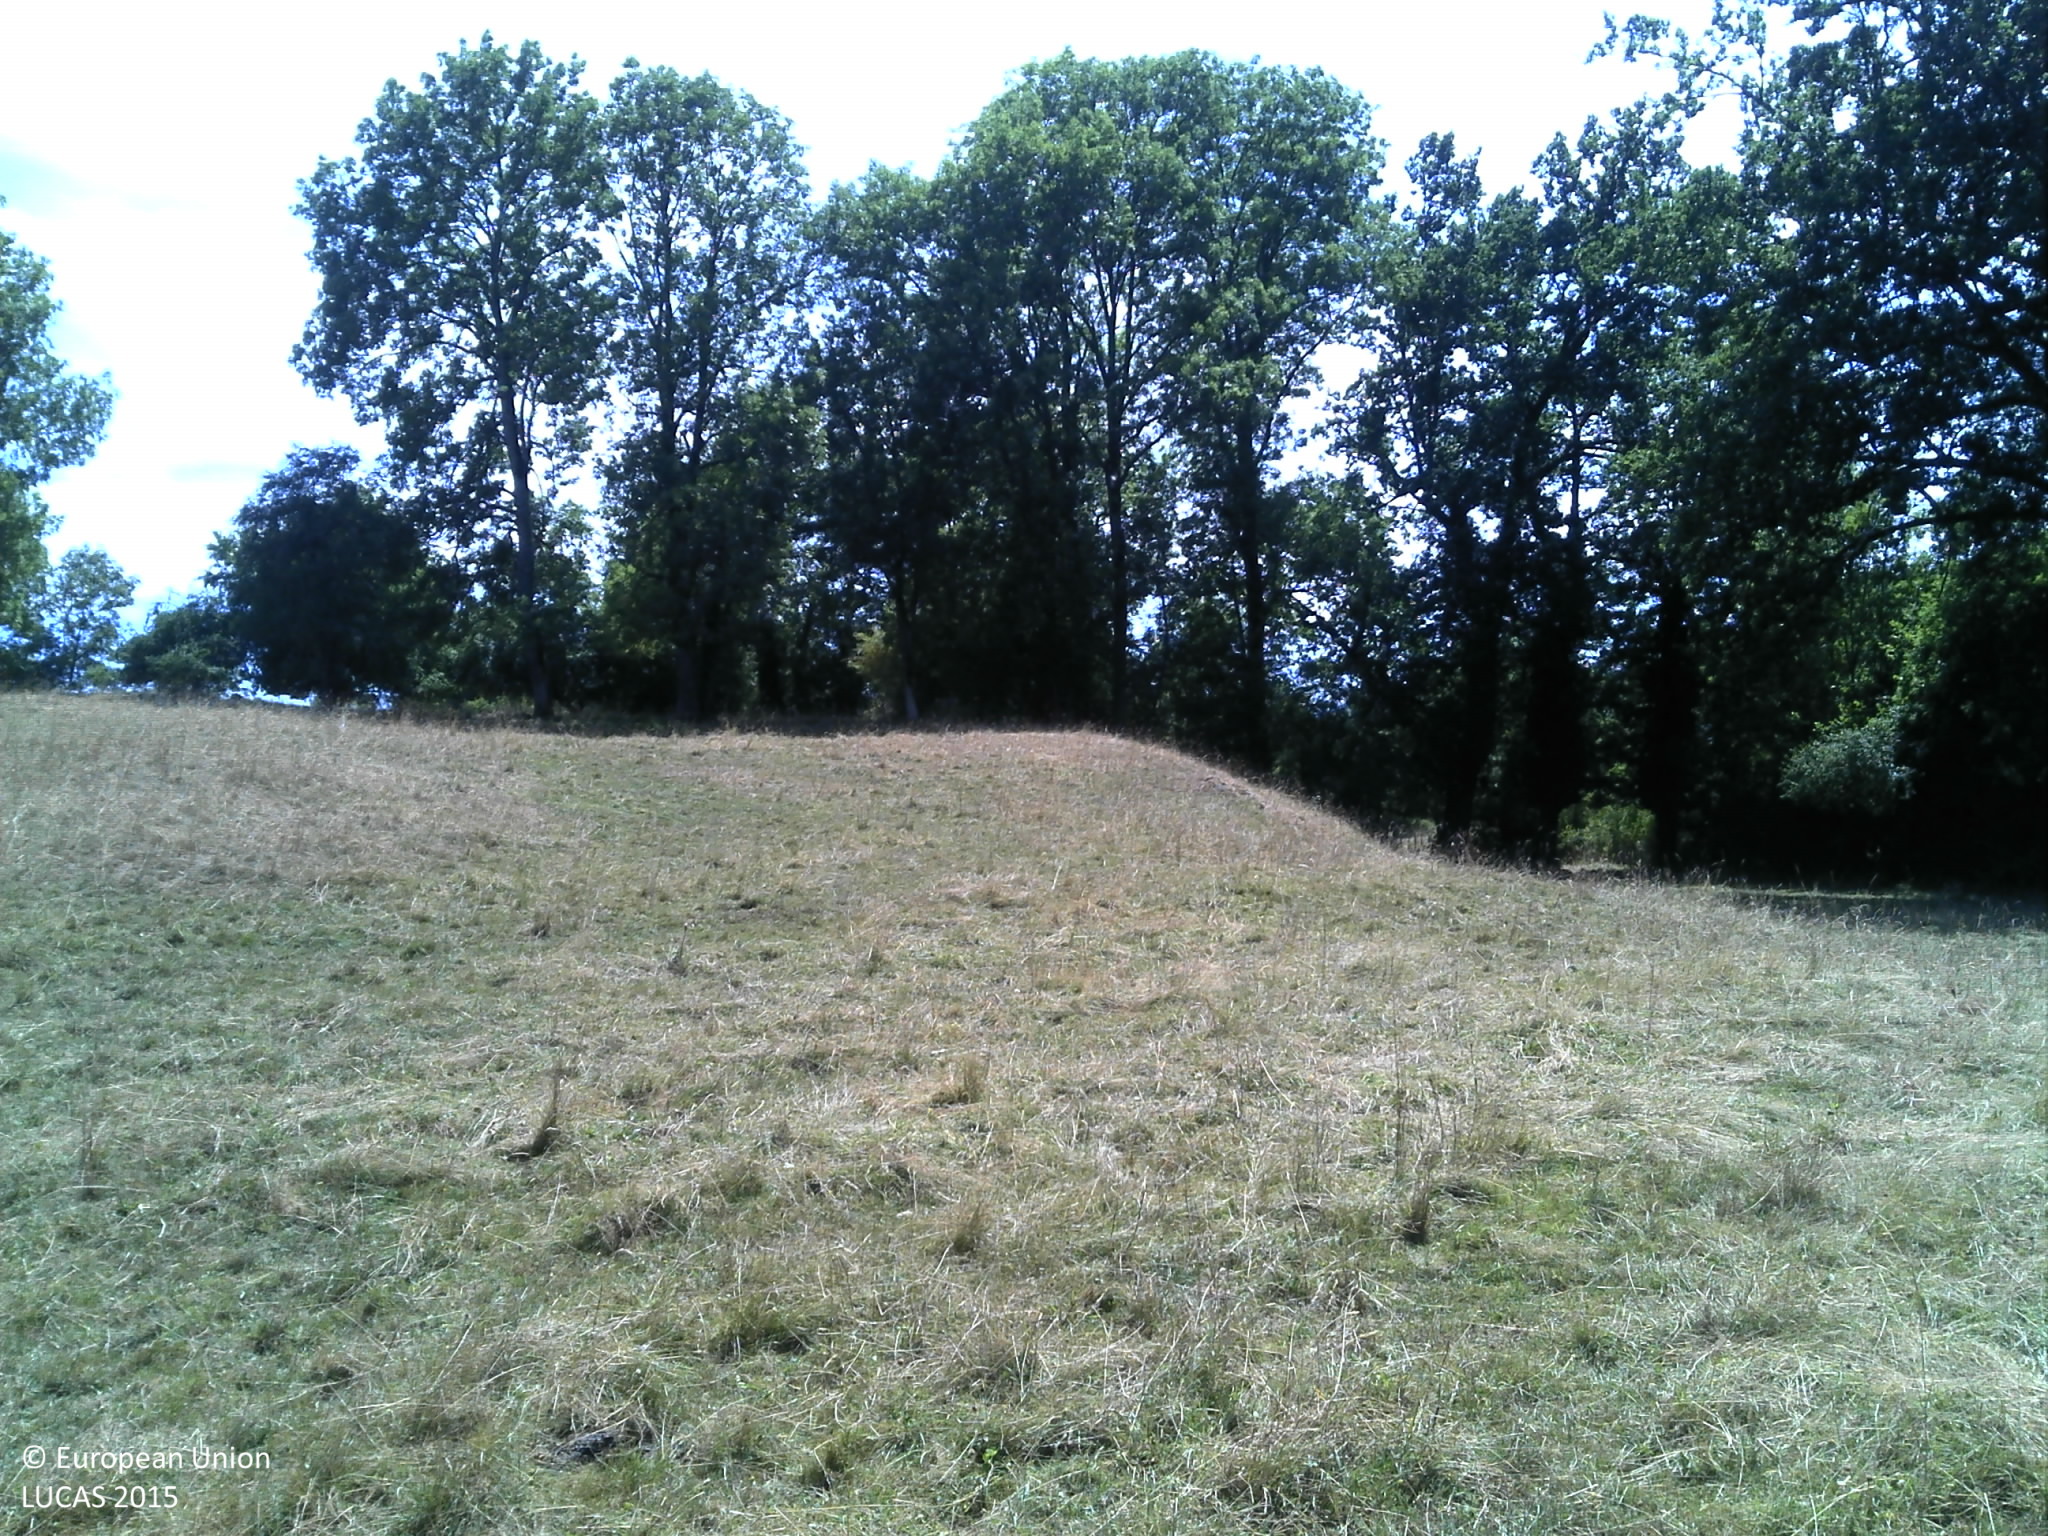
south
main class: Grassland
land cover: Grassland without tree/shrub cover
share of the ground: > 75 %
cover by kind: herbaceous plants 100 %
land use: Agriculture (excluding fallow land and kitchen gardens)
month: July
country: FR
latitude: 45.4263
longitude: 3.7271
